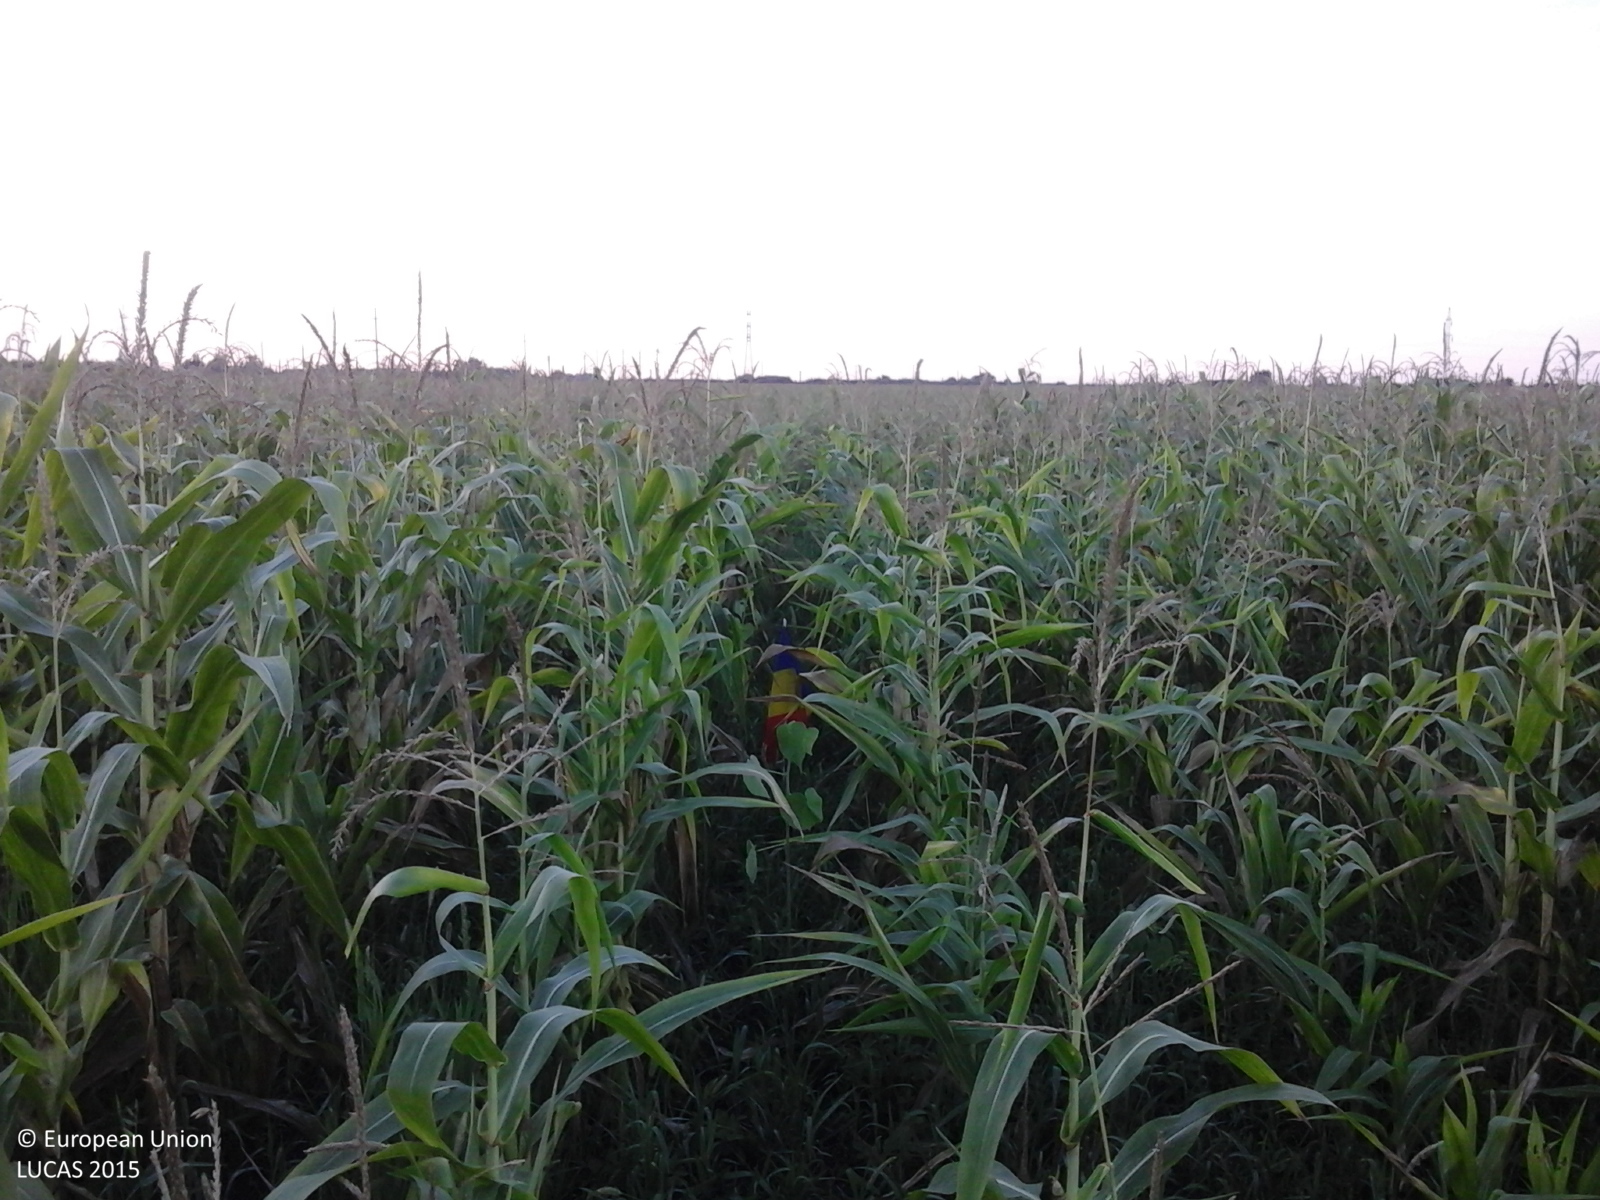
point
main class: Cropland
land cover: Maize
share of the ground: > 75 %
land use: Agriculture (excluding fallow land and kitchen gardens)
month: August
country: RO
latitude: 46.2134
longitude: 21.2194
